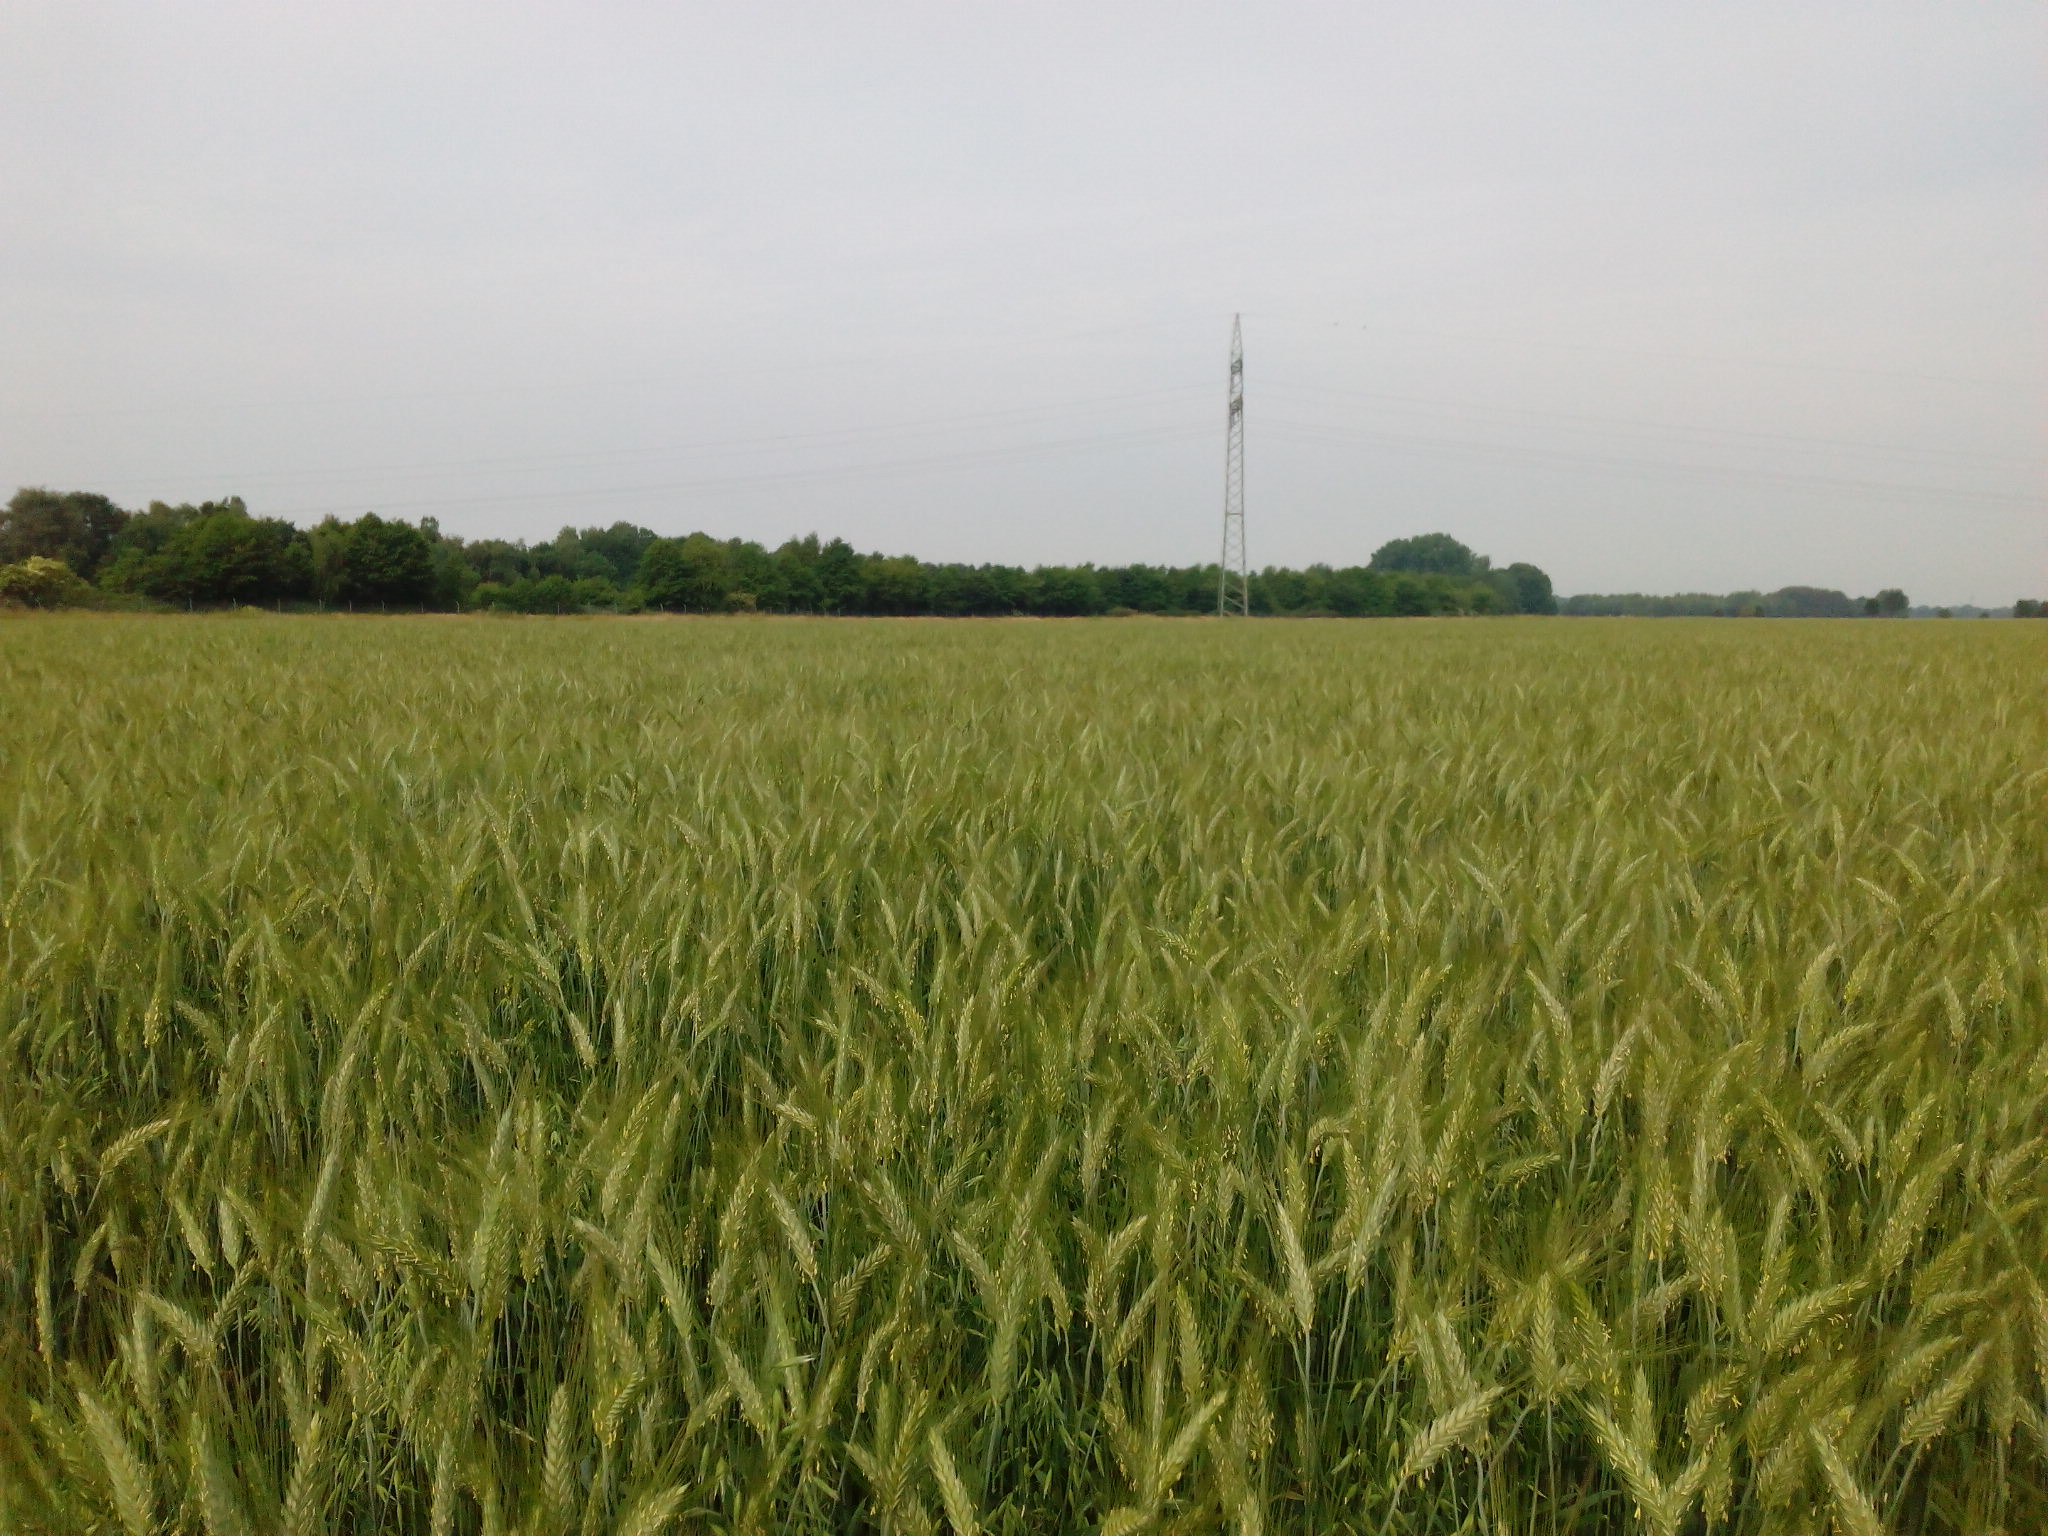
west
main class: Cropland
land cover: Rye
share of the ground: > 75 %
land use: Agriculture (excluding fallow land and kitchen gardens)
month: June
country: DE
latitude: 52.7543
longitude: 9.6297
